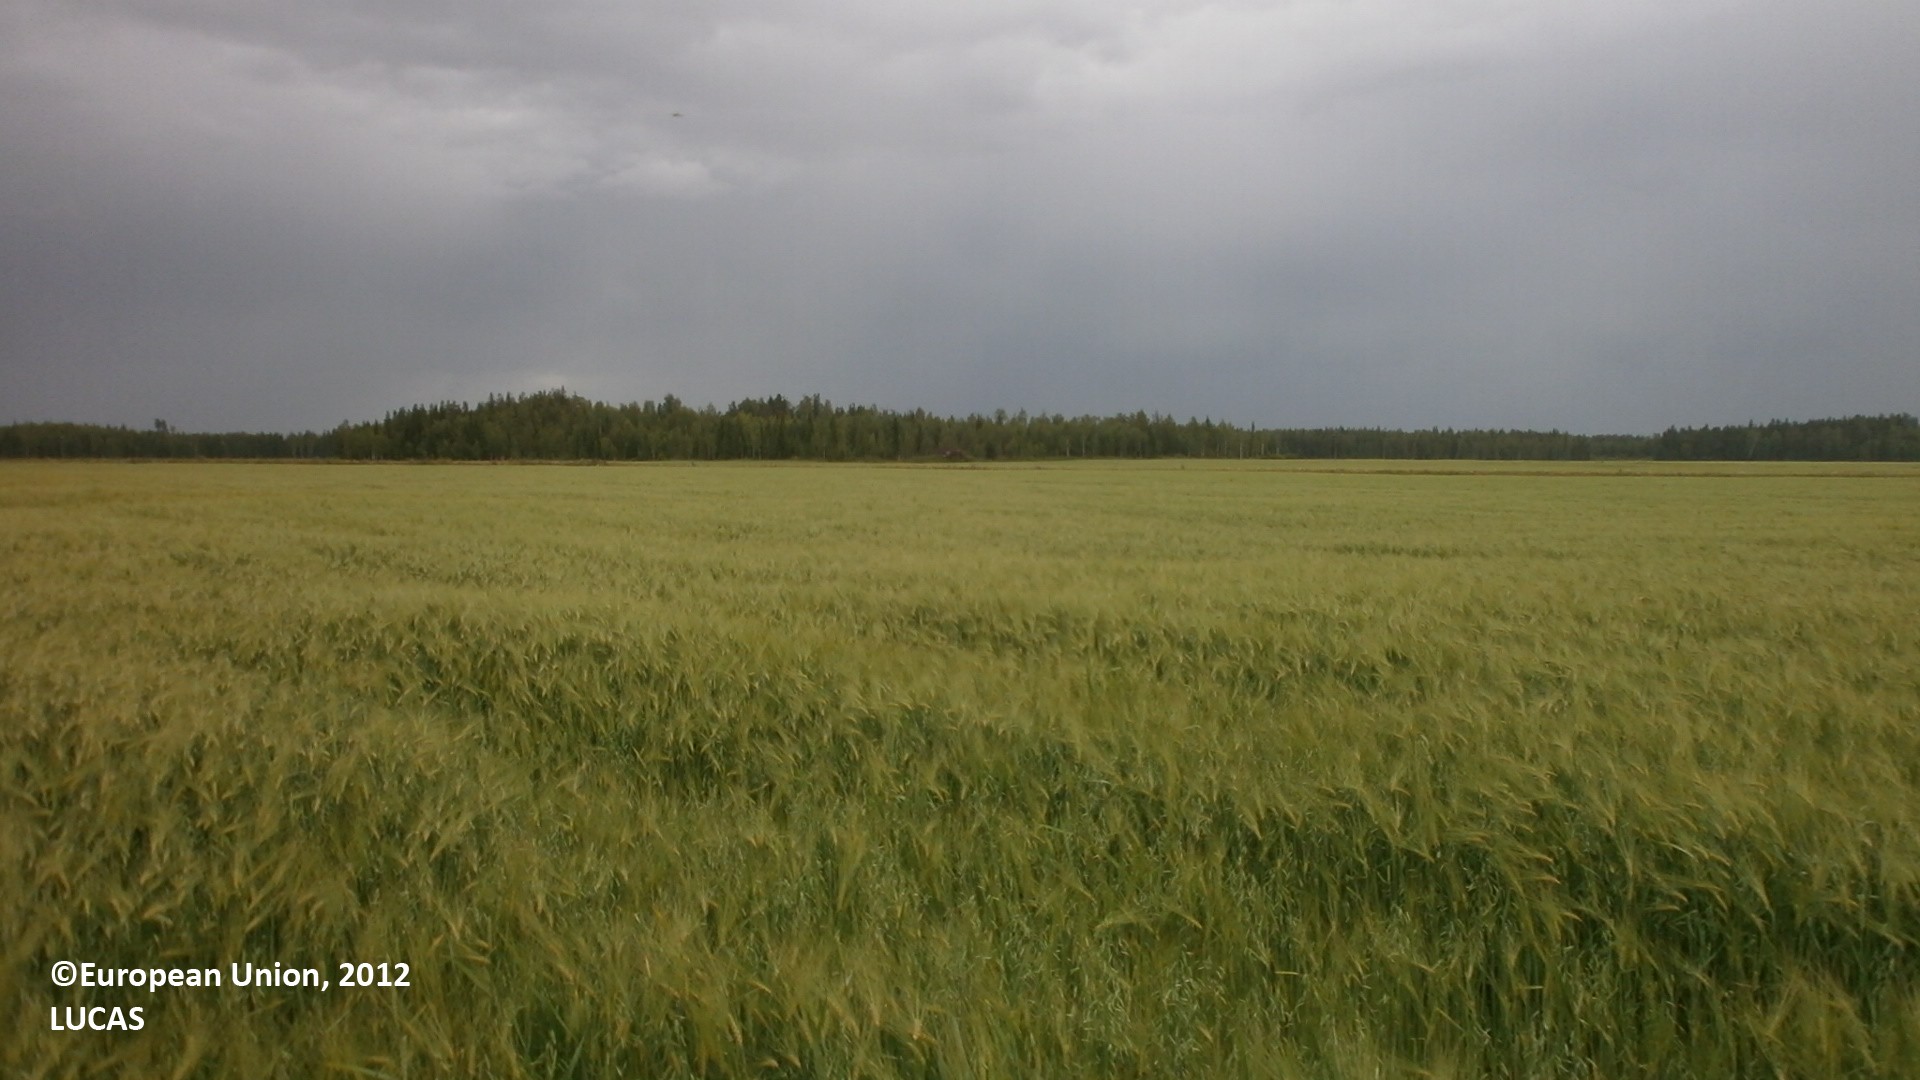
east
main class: Cropland
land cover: Barley
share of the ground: 50 - 75 %
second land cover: Oats
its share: 50 - 75 %
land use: Agriculture (excluding fallow land and kitchen gardens)
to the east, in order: Barley; Oats; Electric lines; Barley
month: July
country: FI
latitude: 63.9174
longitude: 24.2387
